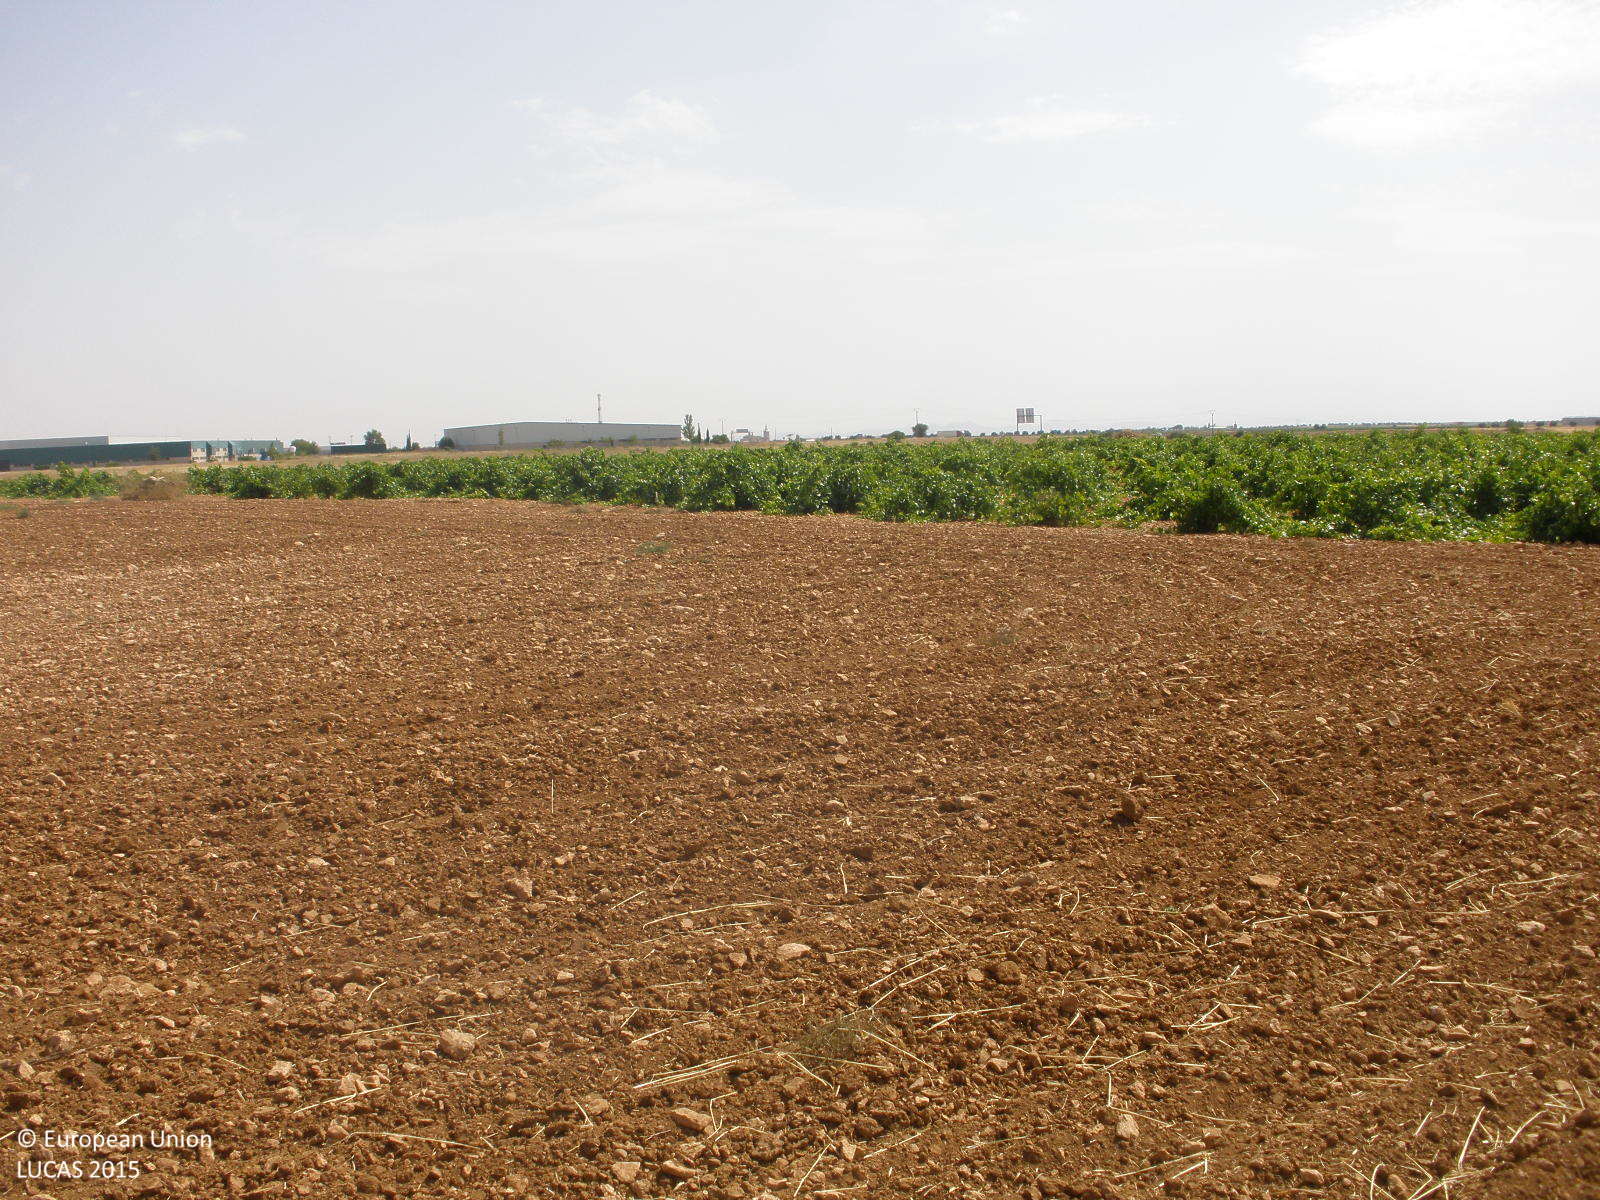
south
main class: Cropland
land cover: Barley
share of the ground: < 10 %
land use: Agriculture (excluding fallow land and kitchen gardens)
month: July
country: ES
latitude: 39.9019
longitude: -3.4671
